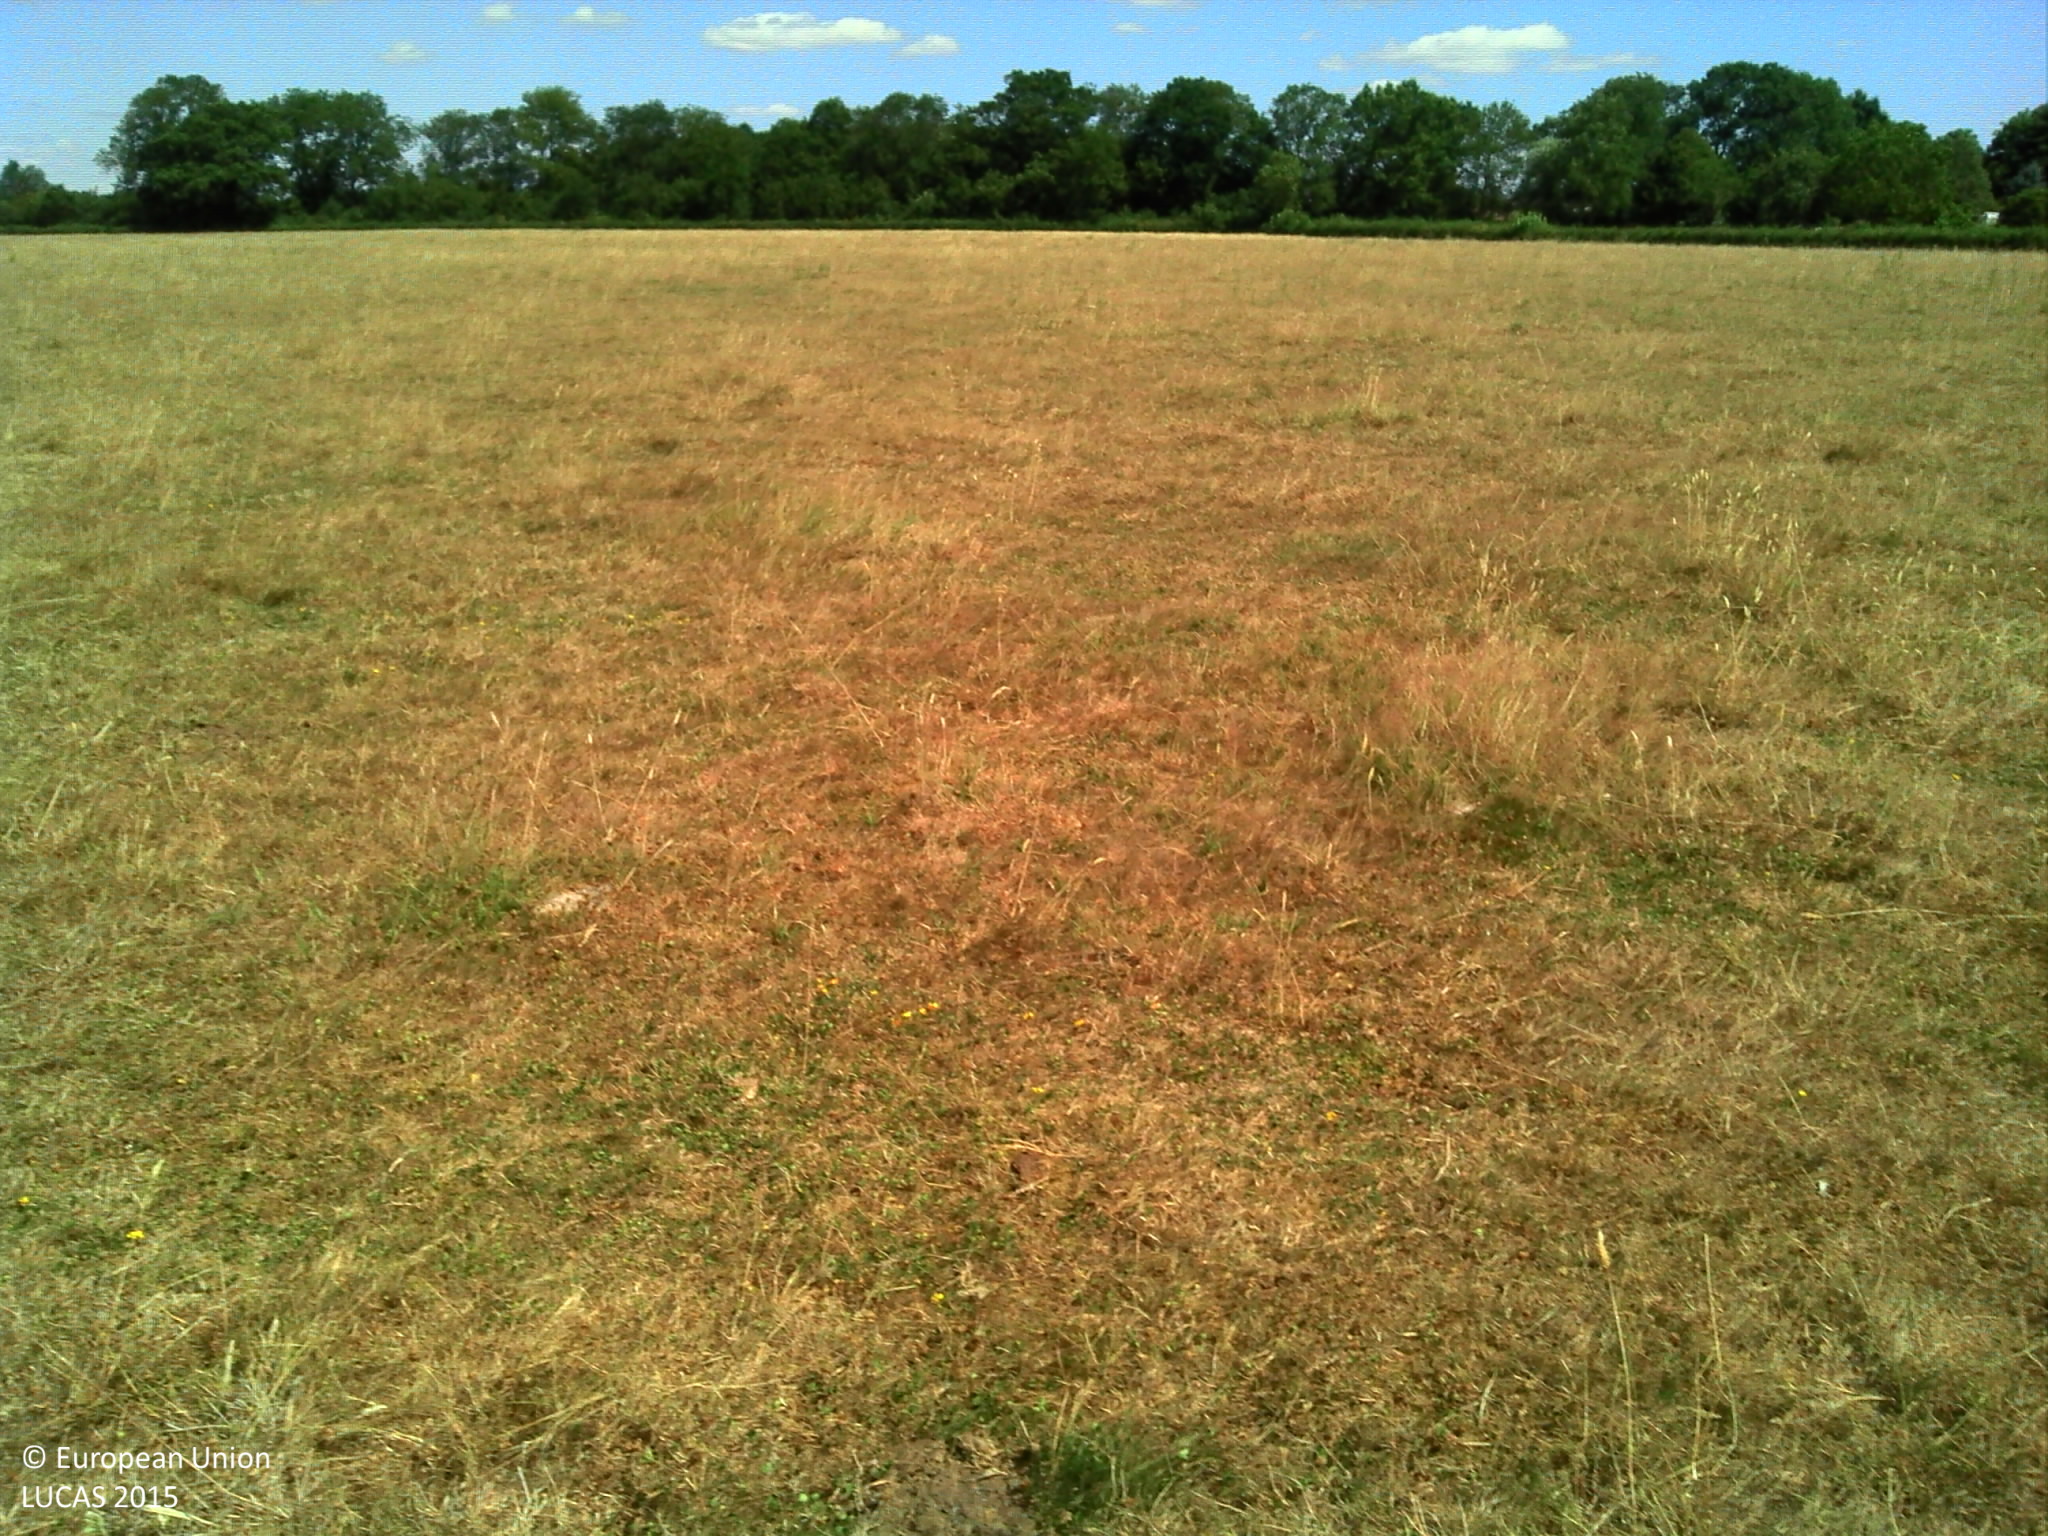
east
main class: Grassland
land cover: Grassland without tree/shrub cover
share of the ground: > 75 %
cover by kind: herbaceous plants 100 %
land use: Agriculture (excluding fallow land and kitchen gardens)
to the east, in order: Grassland without tree/shrub cover; Fences; Managed hedges; Broadleaved woodland; Fences; Grassland without tree/shrub cover
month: July
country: FR
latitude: 46.8482
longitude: 3.6380
